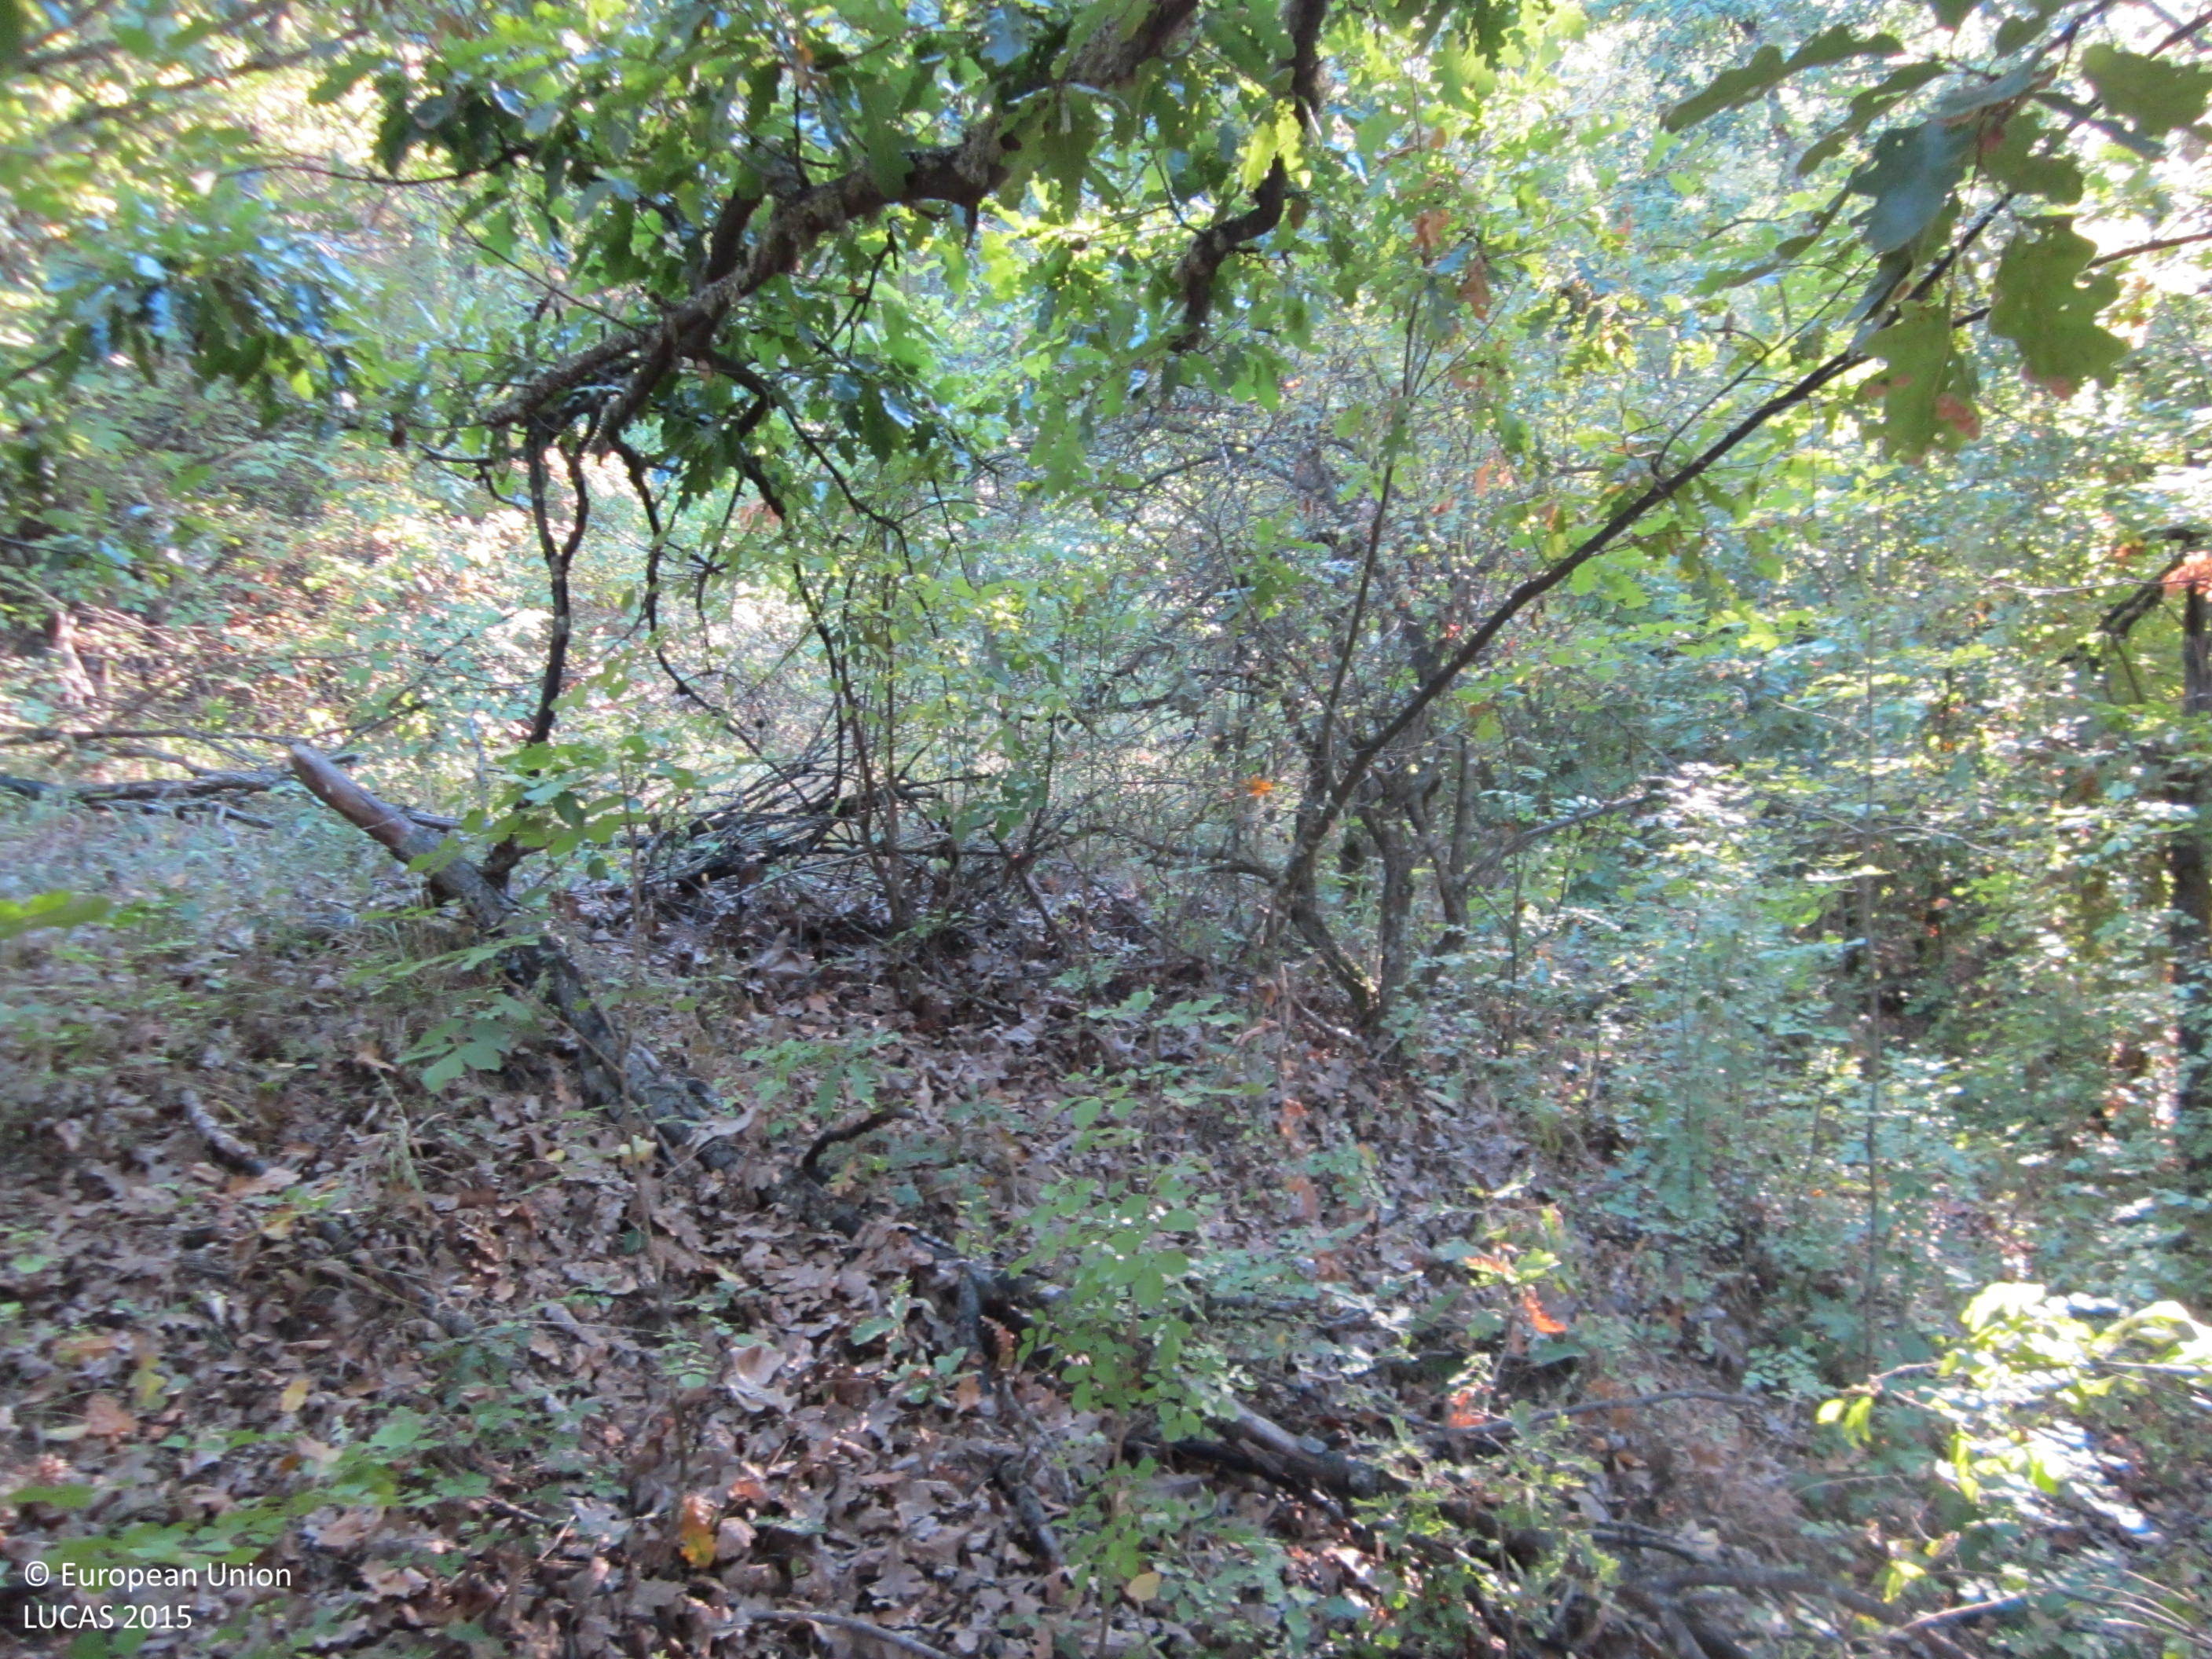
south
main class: Woodland
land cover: Broadleaved woodland
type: thermophilous deciduous forest
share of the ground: 50 - 75 %
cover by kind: broadleaved forest trees 70 %, unconsolidated bare surface 20 %, shrubs 5 %, herbaceous plants 5 %
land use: Forestry
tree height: > 5 m
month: September
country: BG
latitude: 42.1052
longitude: 27.1167
